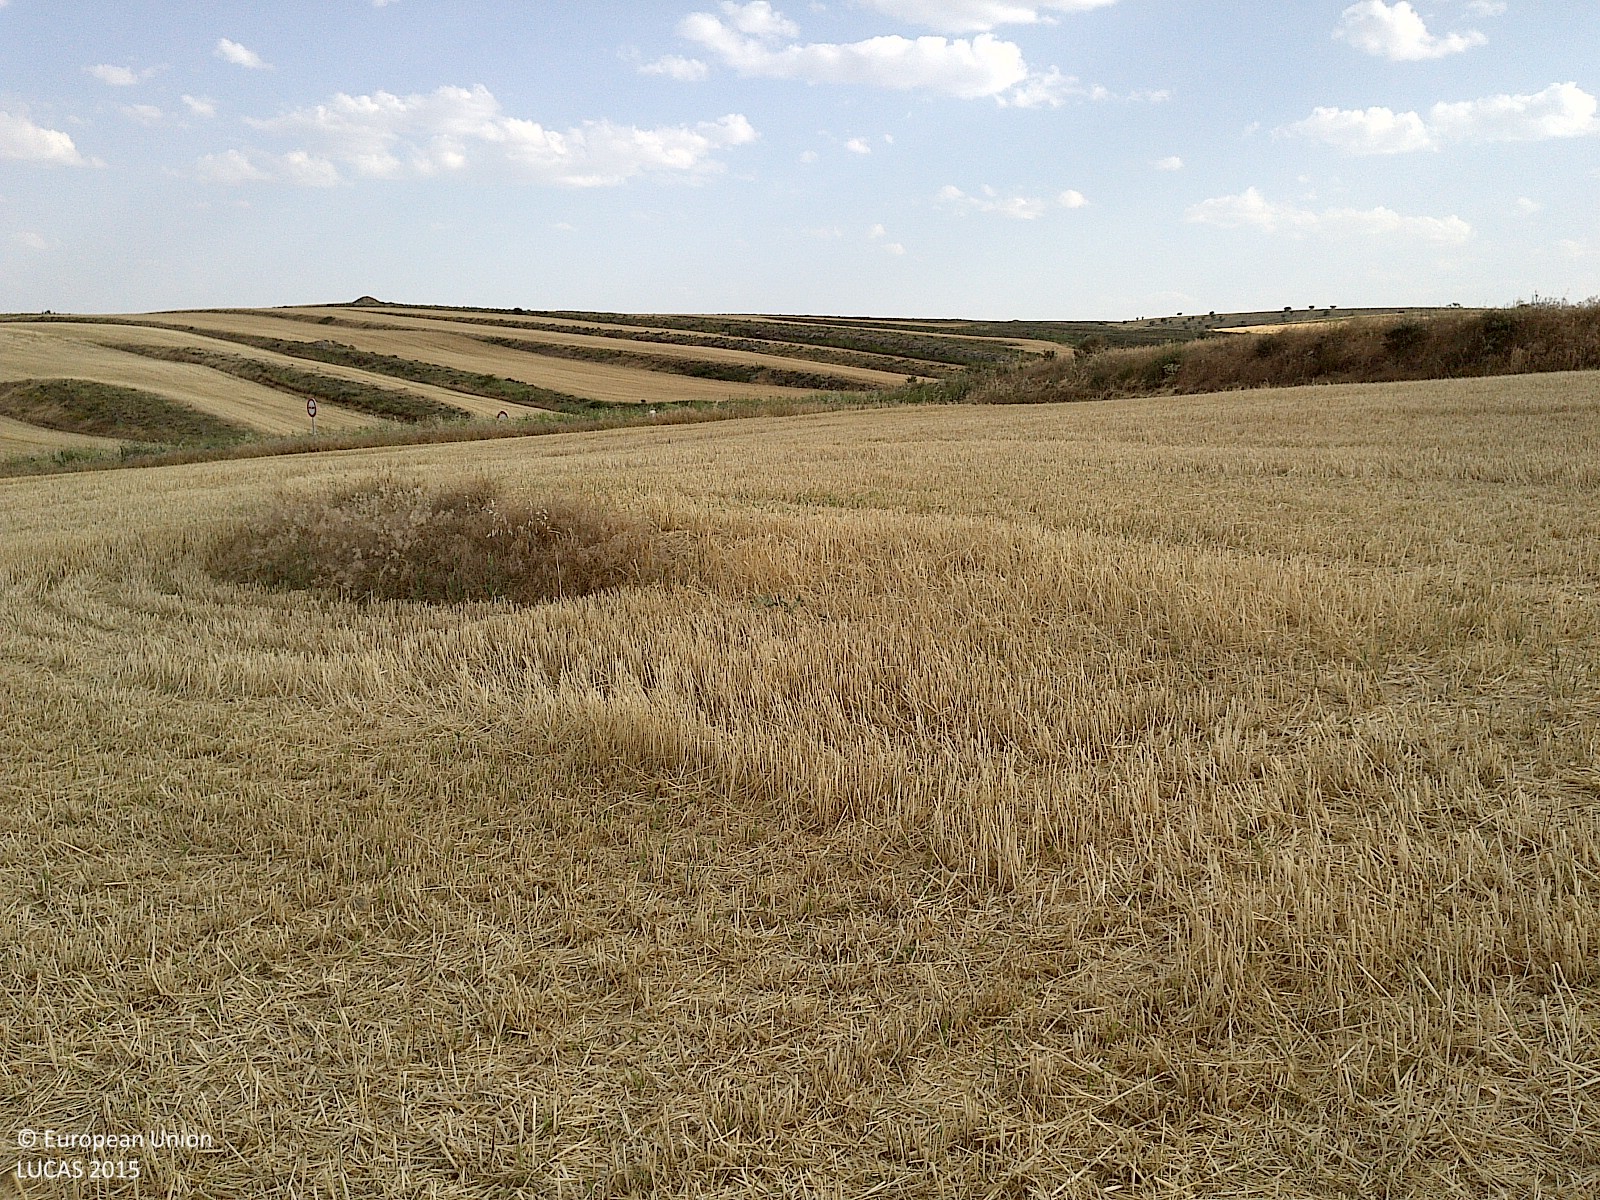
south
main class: Cropland
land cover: Barley
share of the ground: < 10 %
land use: Agriculture (excluding fallow land and kitchen gardens)
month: June
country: ES
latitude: 41.6404
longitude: -2.1952
